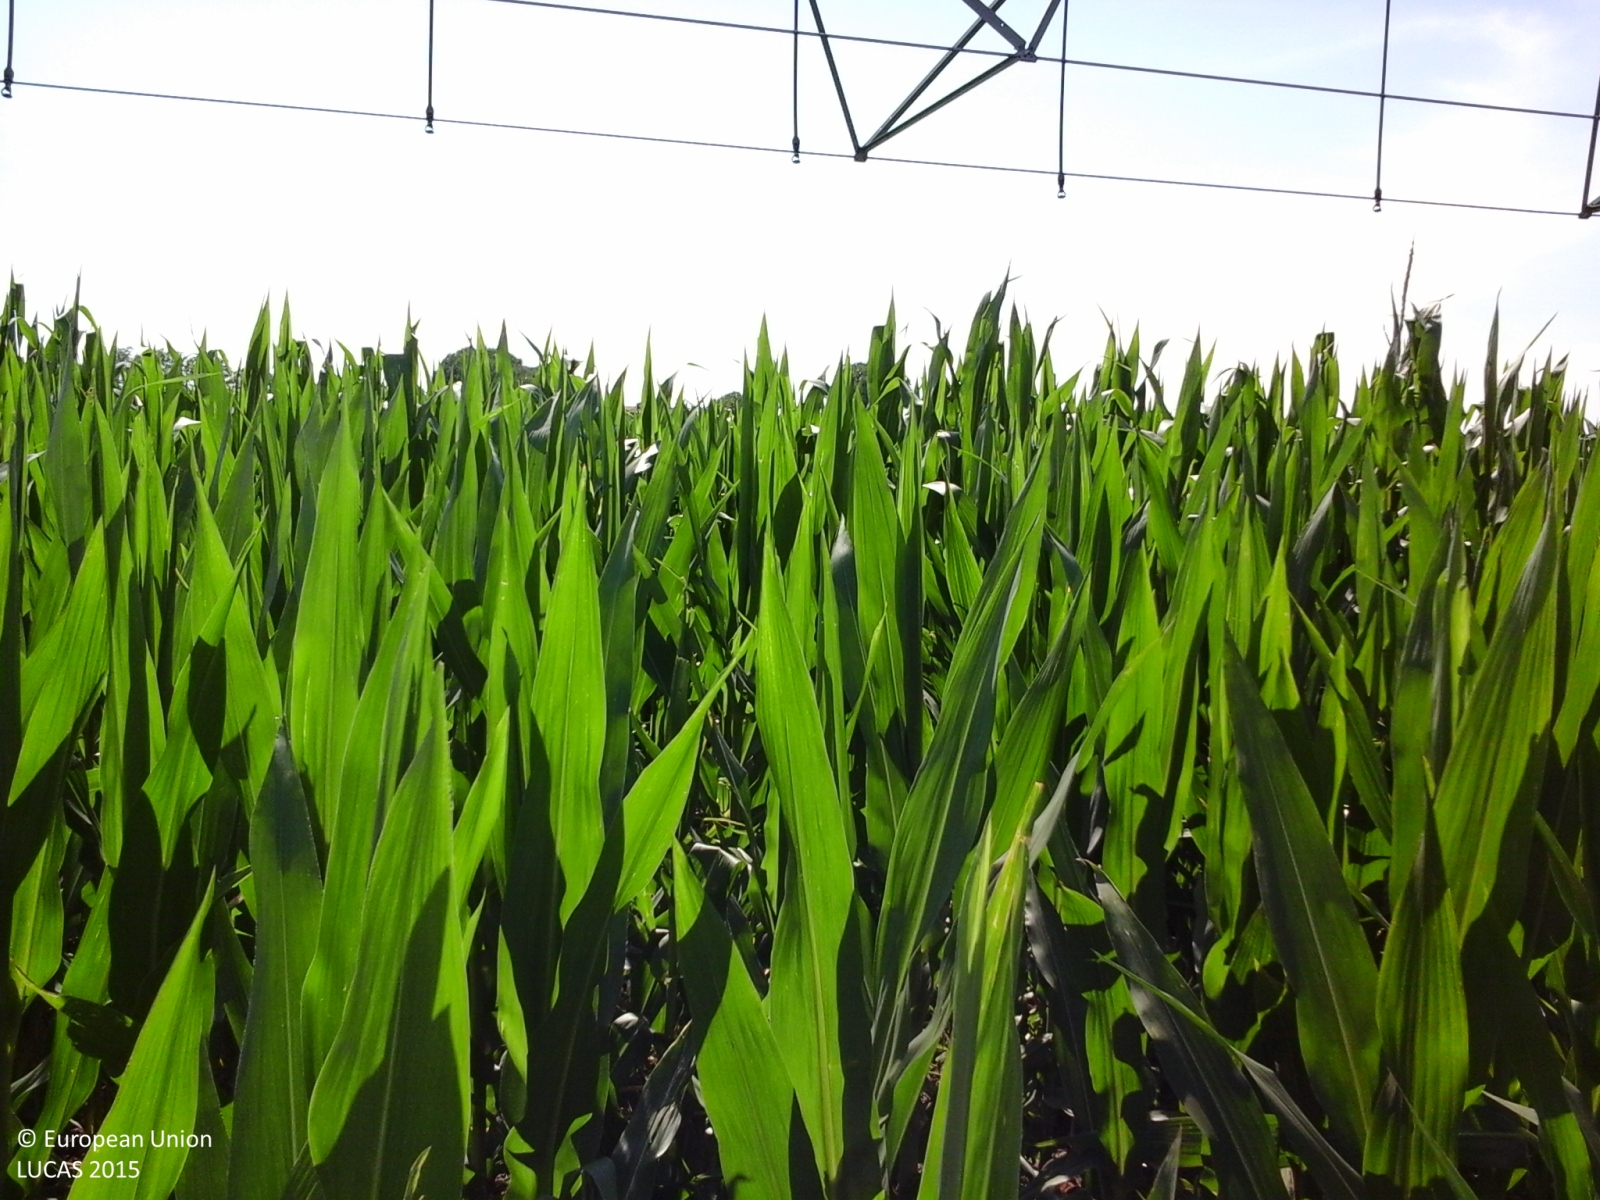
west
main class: Cropland
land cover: Maize
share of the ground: > 75 %
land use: Agriculture (excluding fallow land and kitchen gardens)
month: June
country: IT
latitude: 44.9588
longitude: 12.1891
